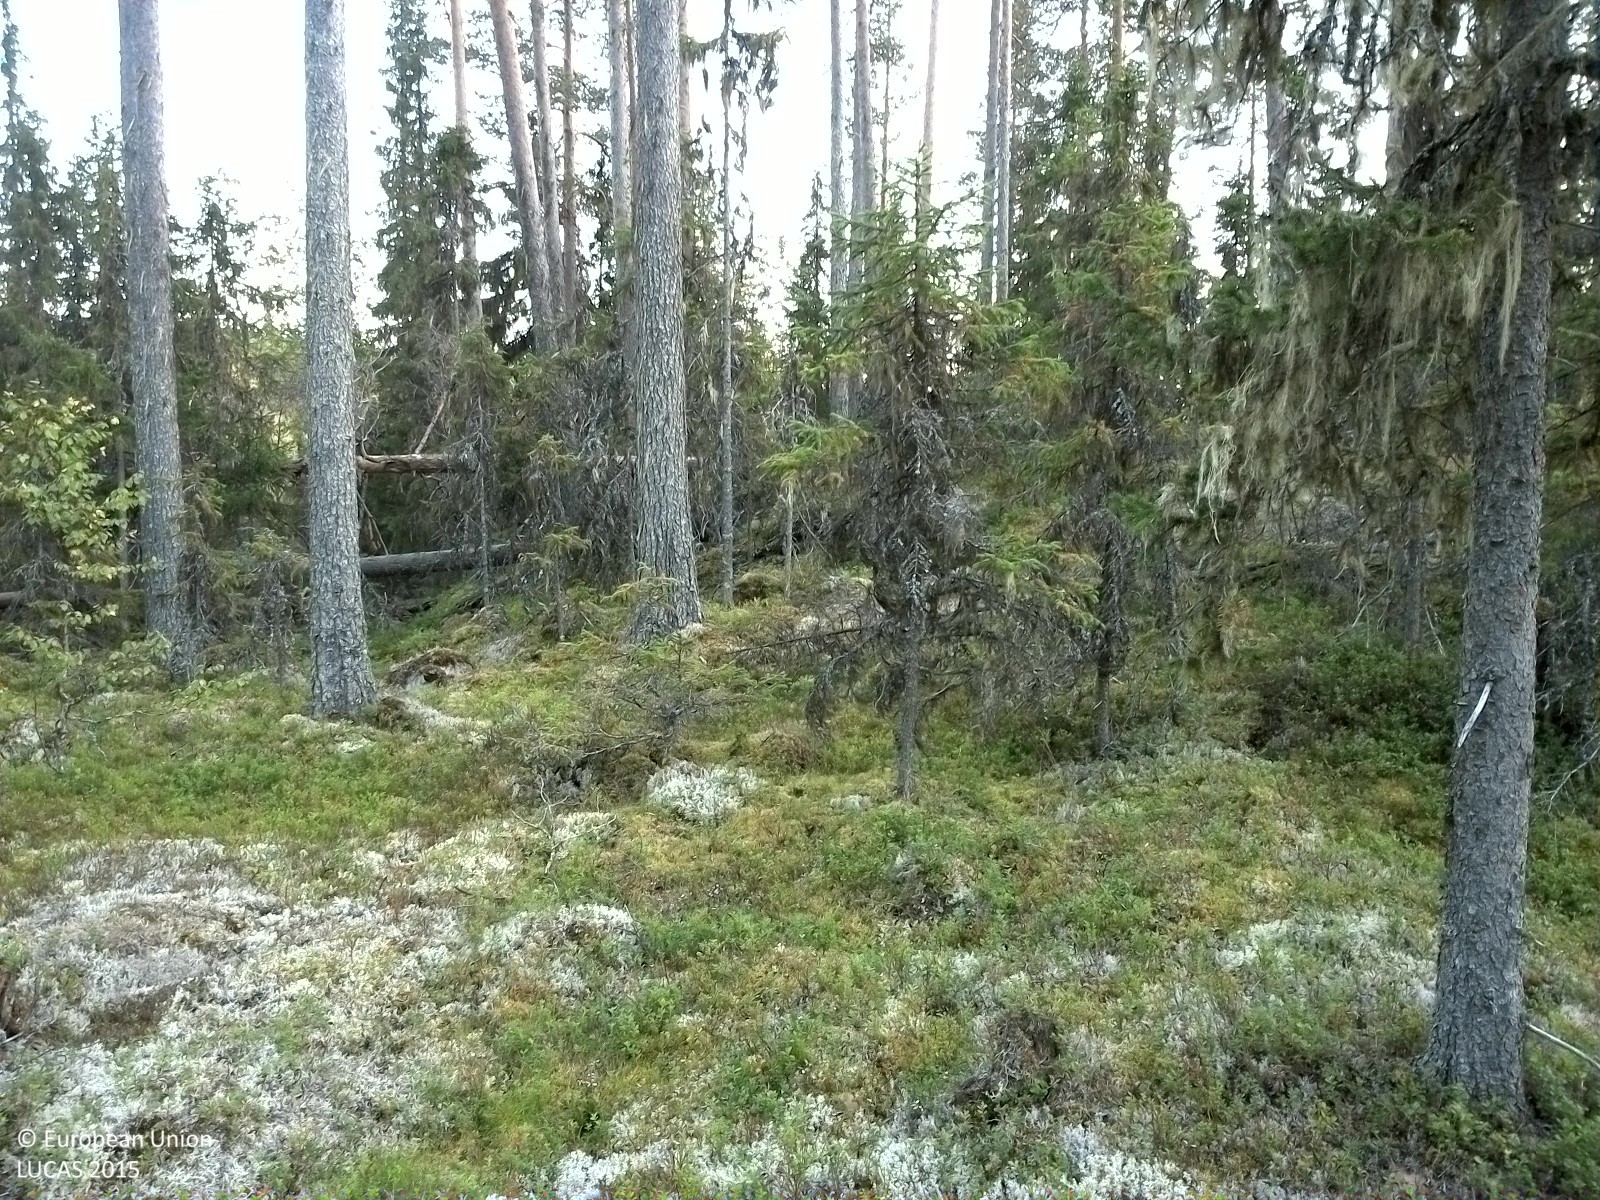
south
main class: Woodland
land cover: Other mixed woodland
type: boreal forest
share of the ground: 50 - 75 %
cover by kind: coniferous forest trees 40 %, lichens and mosses 25 %, shrubs 20 %, broadleaved forest trees 15 %
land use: Forestry
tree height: > 5 m
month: September
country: SE
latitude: 62.6326
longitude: 16.1208
